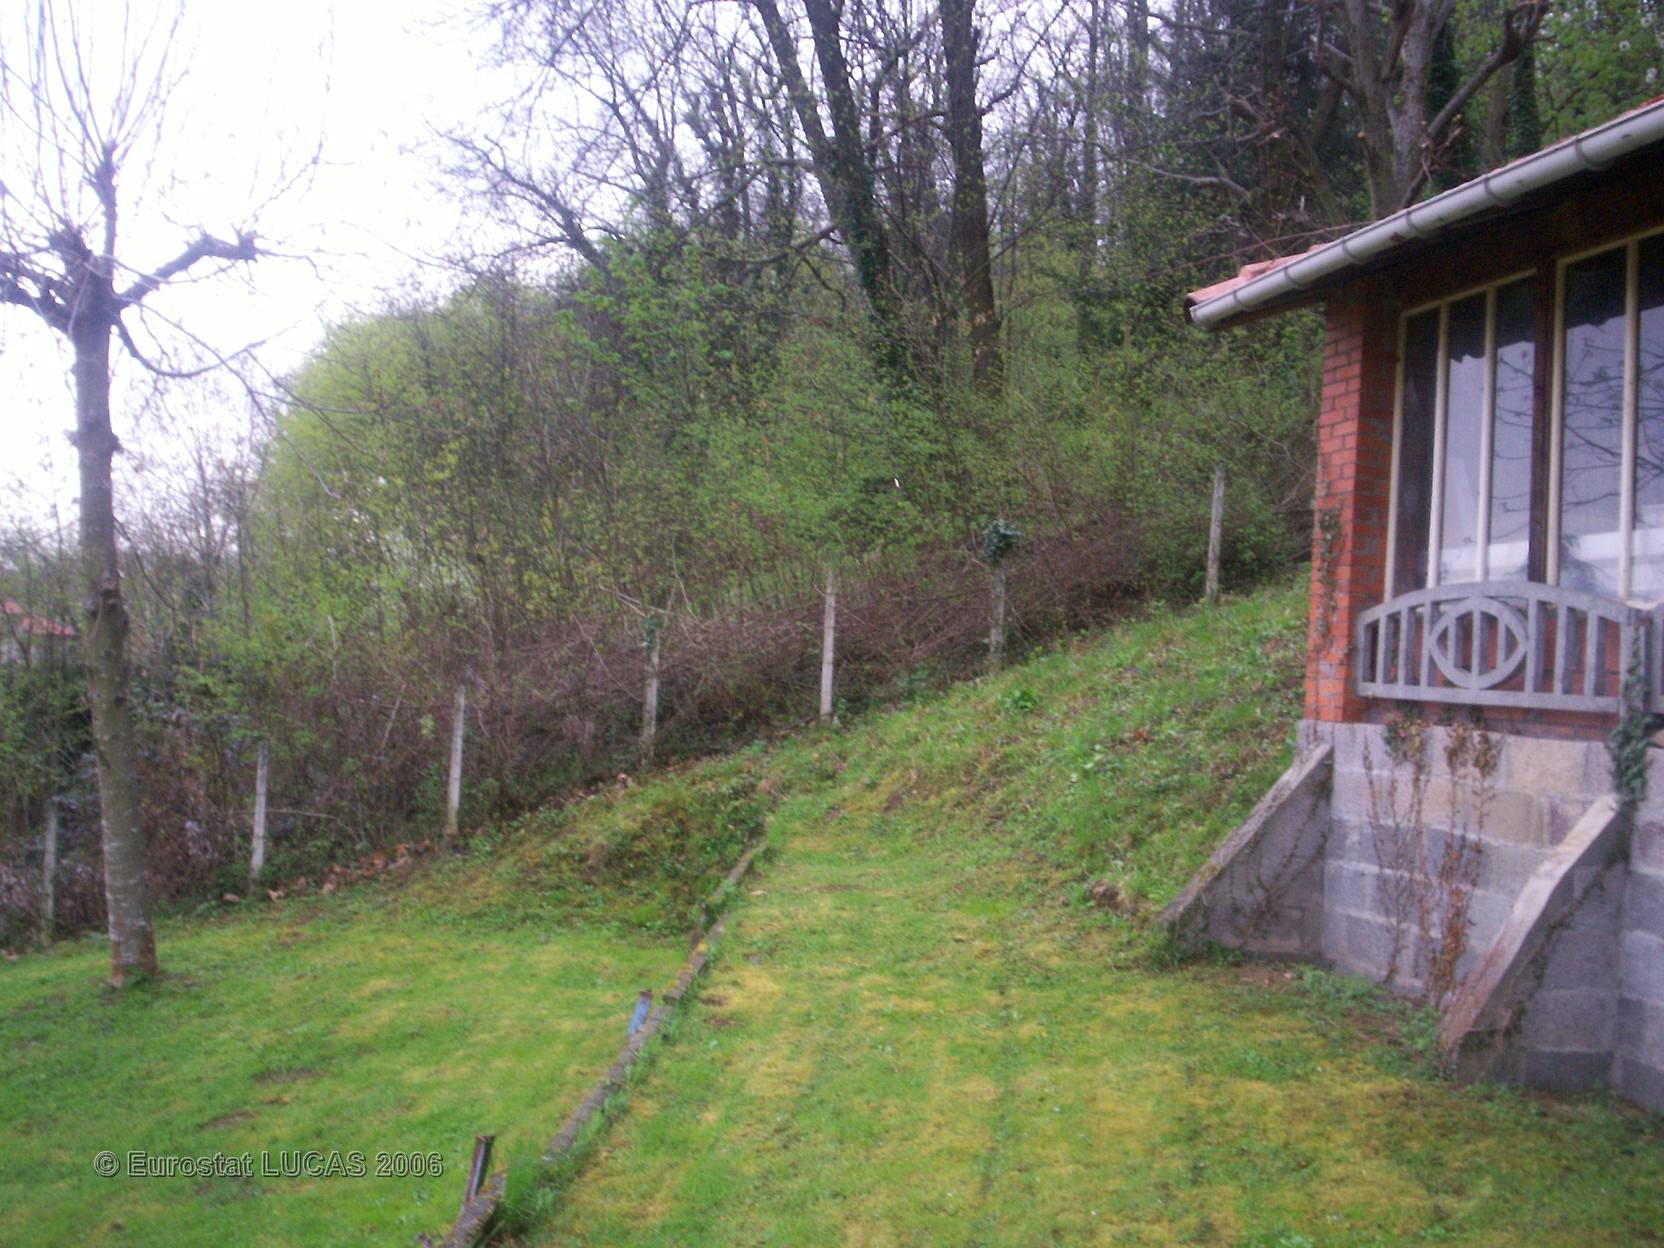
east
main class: Grassland
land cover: Grassland with sparse tree/shrub cover
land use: Residential
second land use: Kitchen garden
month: April
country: FR
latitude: 45.7631
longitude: 3.0436
